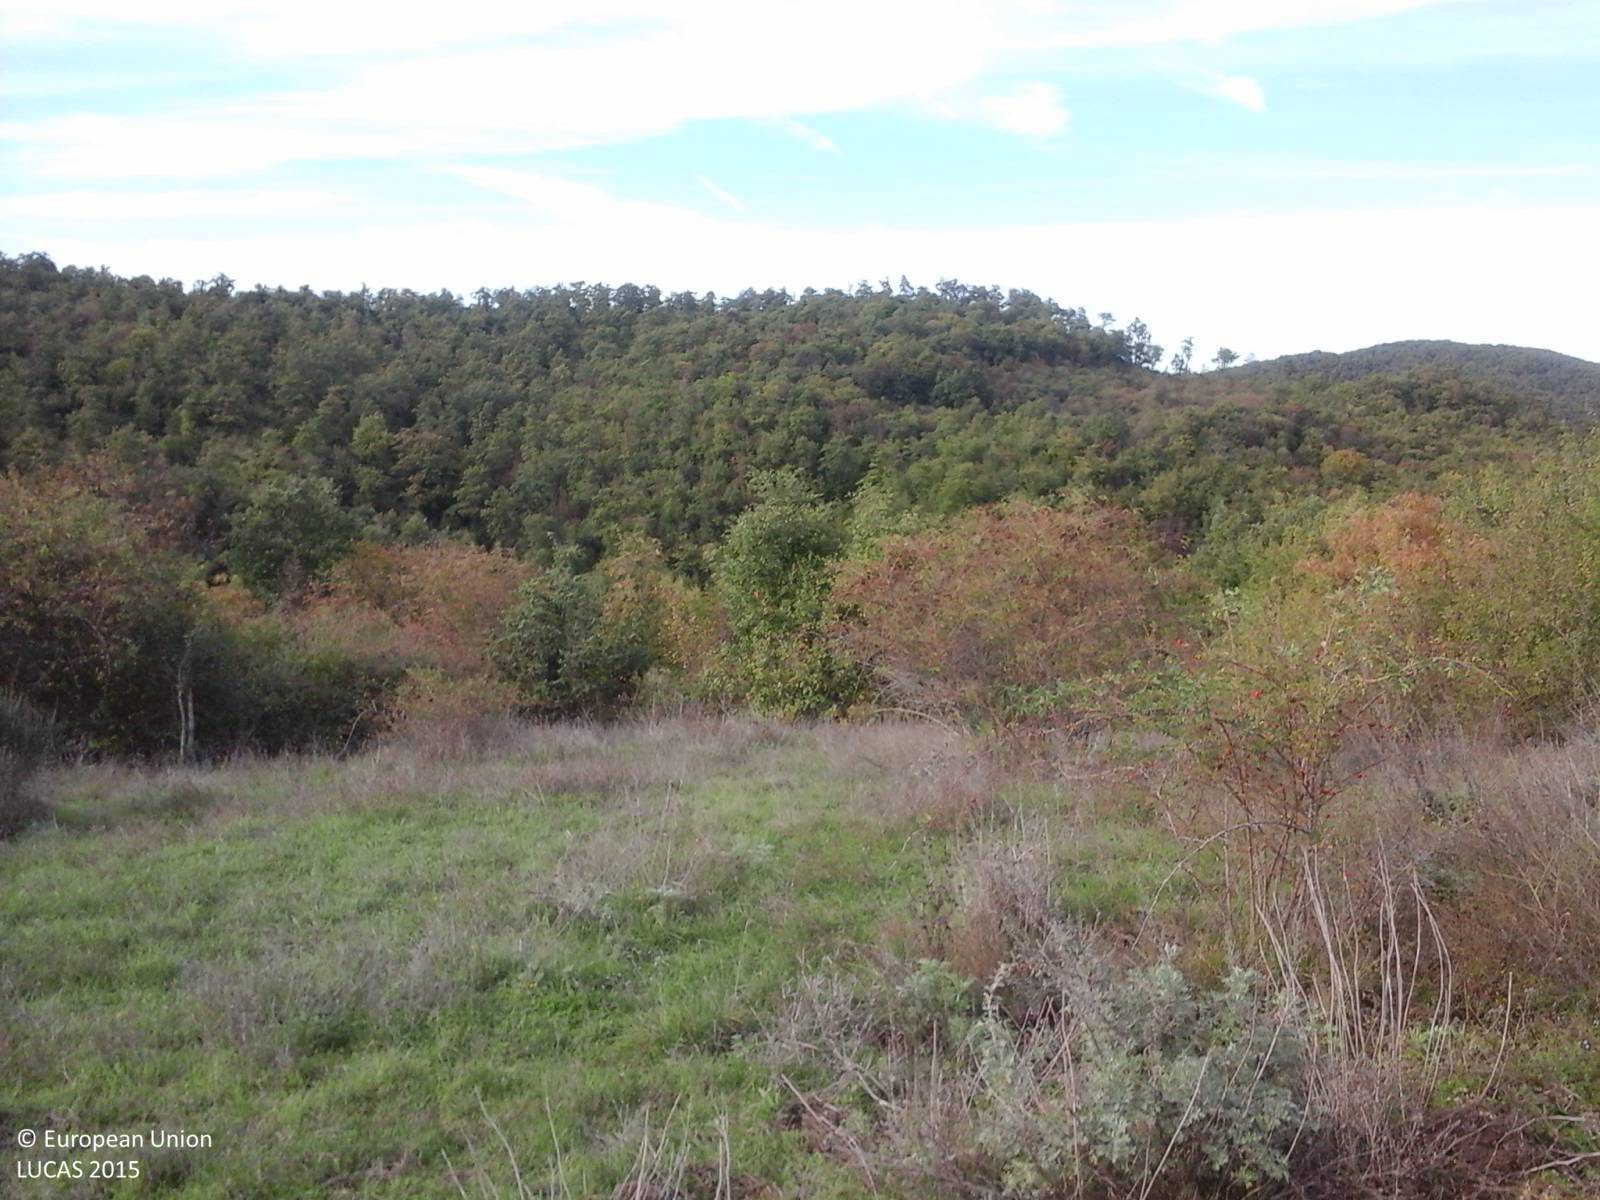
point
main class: Woodland
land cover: Broadleaved woodland
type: thermophilous deciduous forest
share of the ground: > 75 %
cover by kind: broadleaved forest trees 100 %
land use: Forestry
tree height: > 5 m
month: October
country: IT
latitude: 42.8276
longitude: 12.2560
